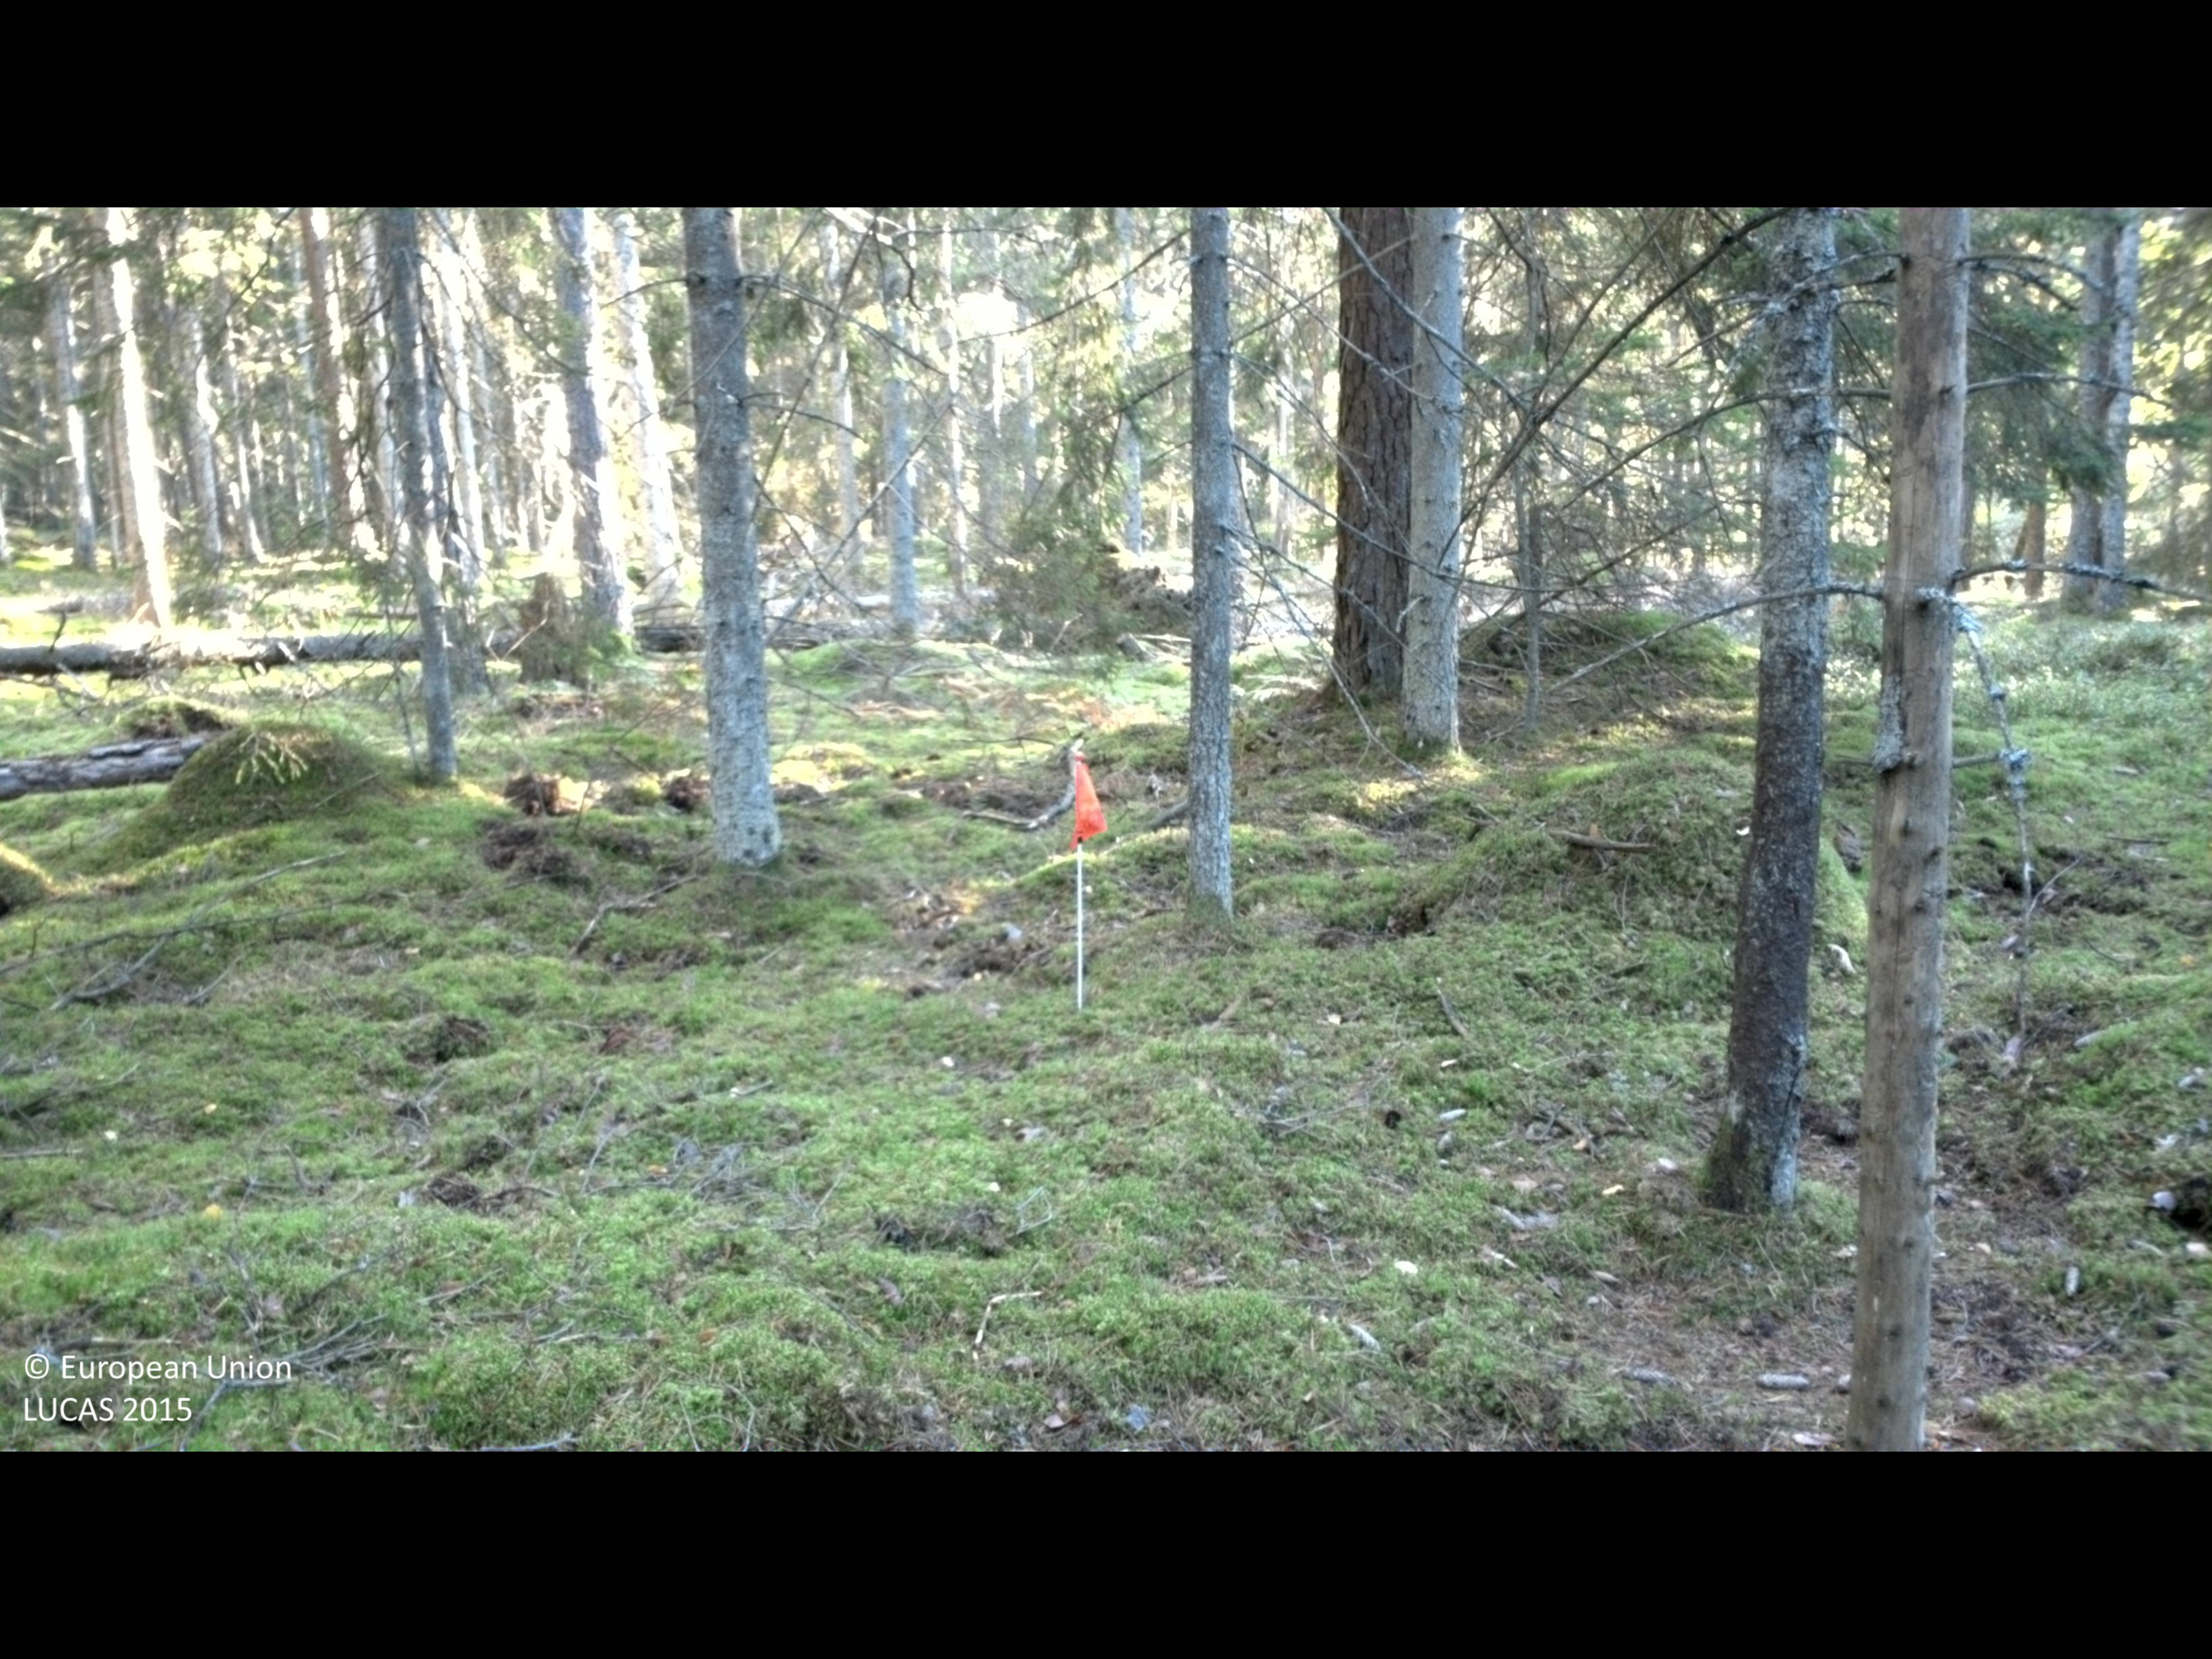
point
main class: Woodland
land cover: Spruce dominated coniferous woodland
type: boreal forest
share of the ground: > 75 %
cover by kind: coniferous forest trees 75 %, lichens and mosses 15 %, shrubs 10 %
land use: Forestry
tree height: > 5 m
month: September
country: SE
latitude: 56.3171
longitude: 15.1885
